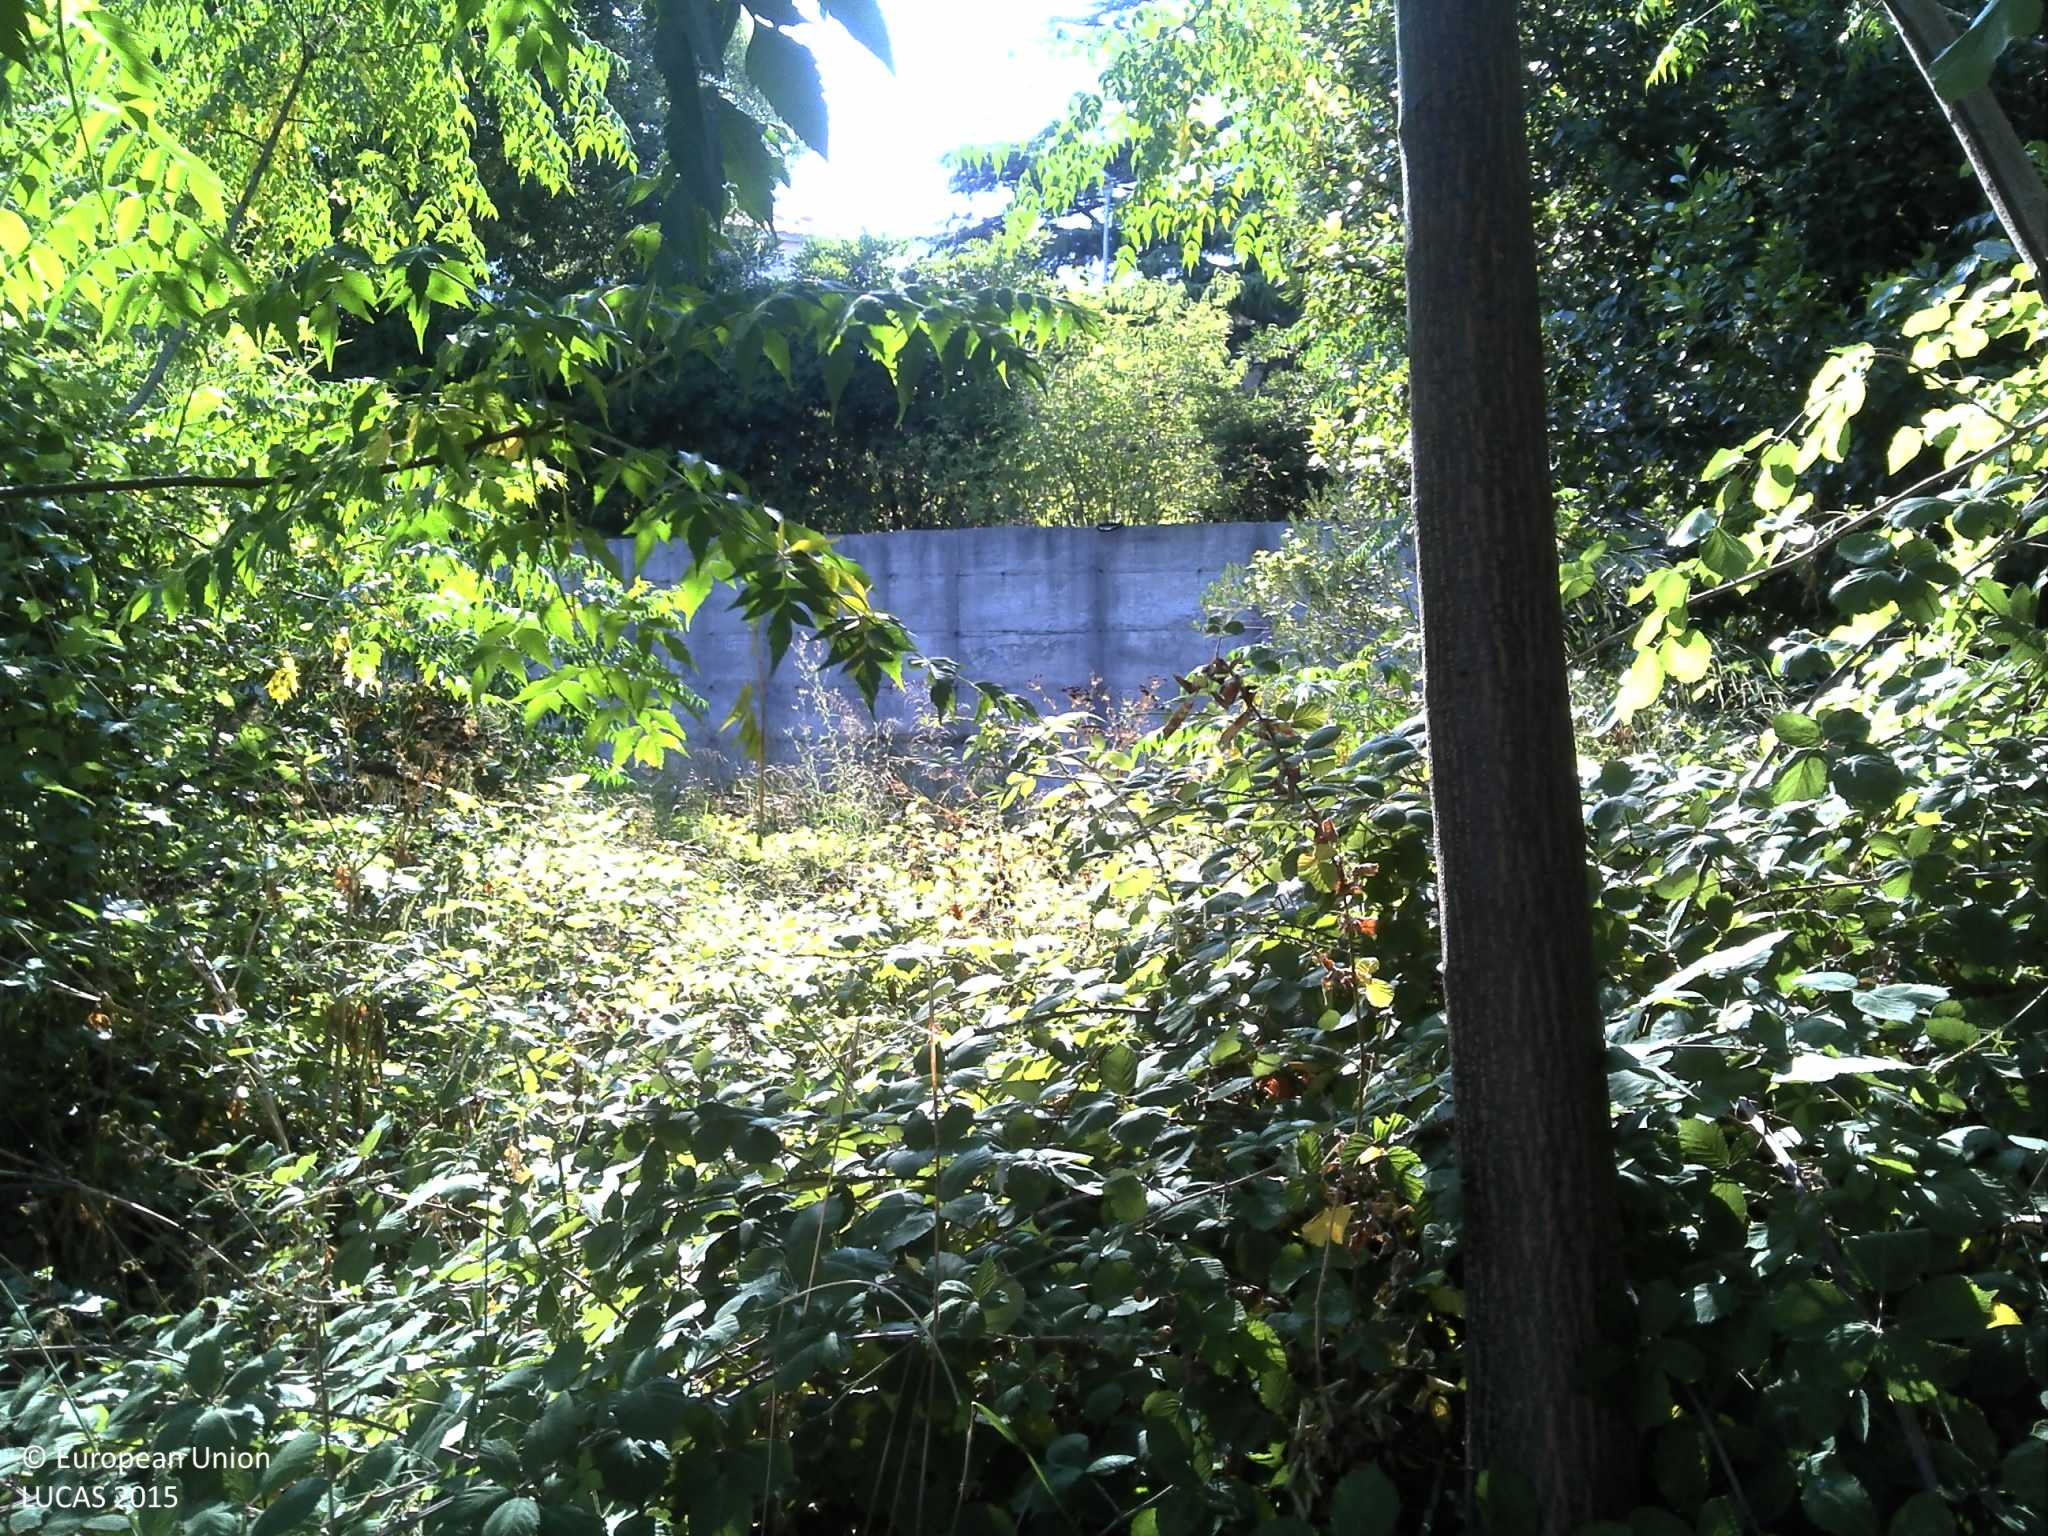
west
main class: Woodland
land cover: Broadleaved woodland
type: thermophilous deciduous forest
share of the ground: 50 - 75 %
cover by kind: broadleaved forest trees 55 %, herbaceous plants 15 %, coniferous forest trees 10 %, consolidated bare surface 10 %, lichens and mosses 5 %, unconsolidated bare surface 5 %
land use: Amenities, museums, leisure
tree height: > 5 m
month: July
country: HR
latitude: 42.6575
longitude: 18.0783
